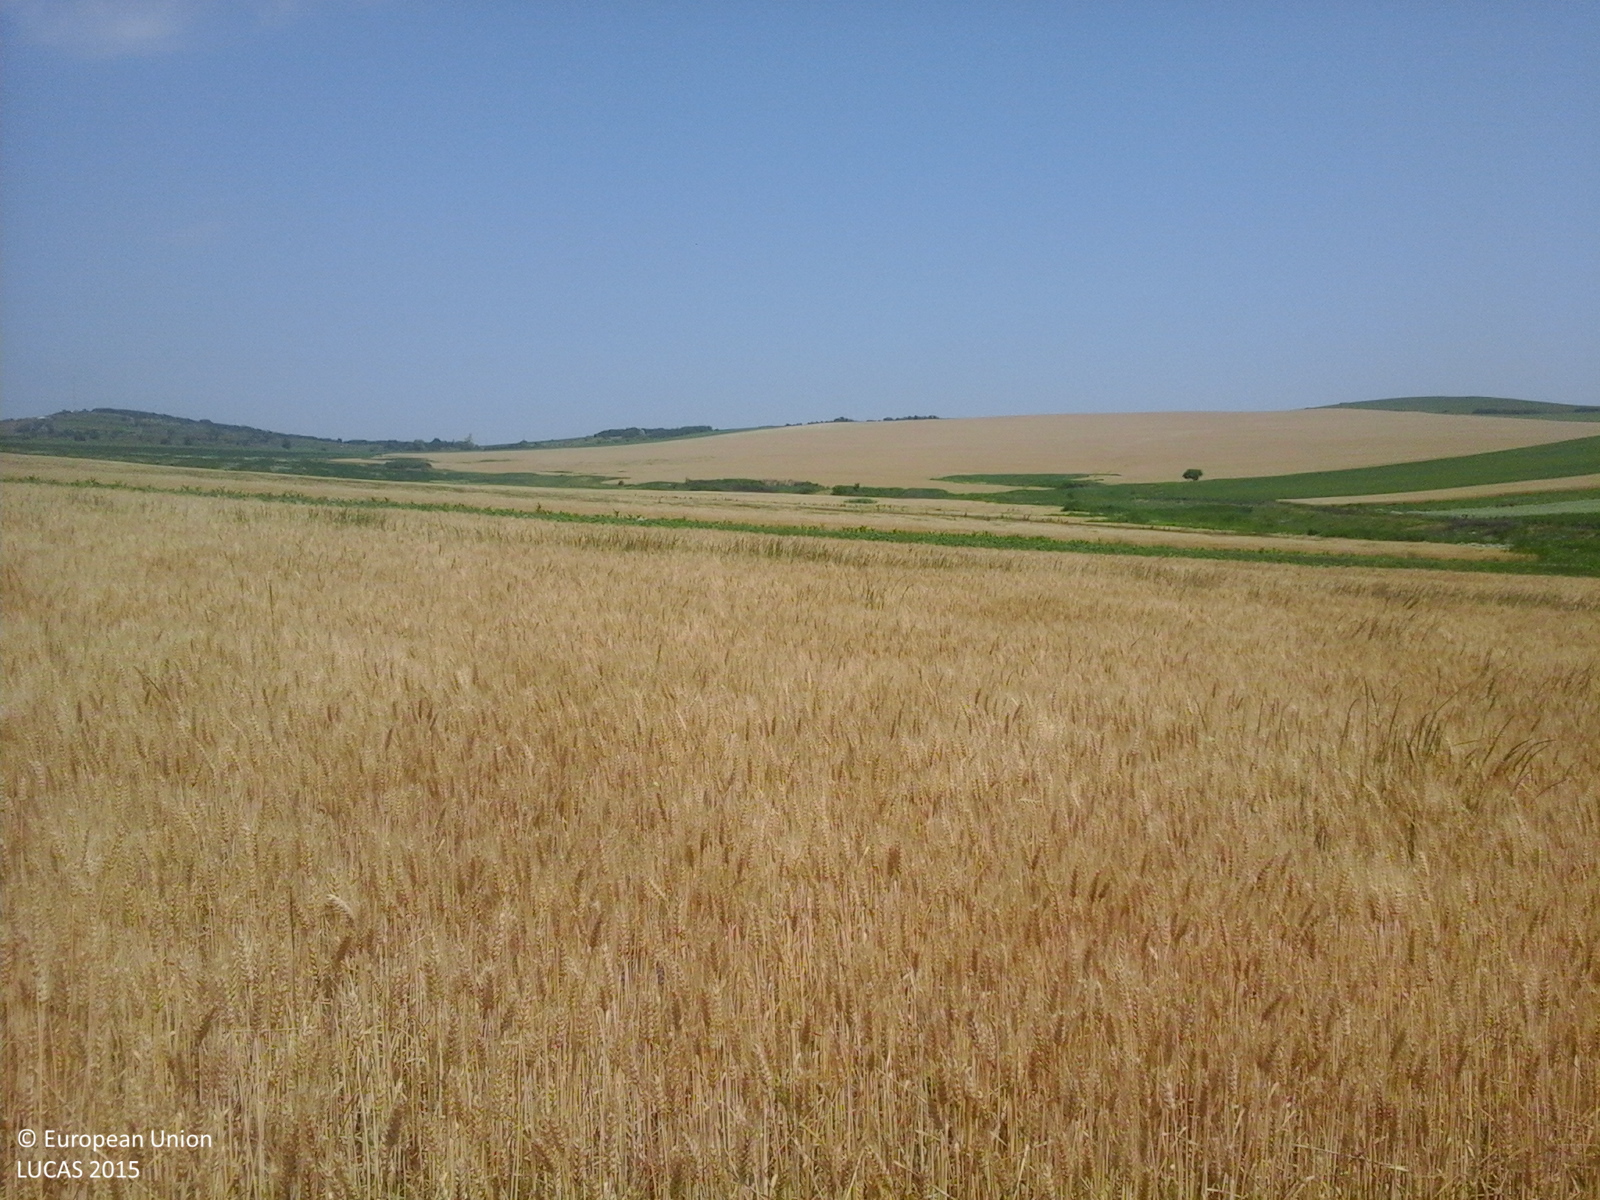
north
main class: Cropland
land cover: Common wheat
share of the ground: > 75 %
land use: Agriculture (excluding fallow land and kitchen gardens)
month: June
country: RO
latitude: 46.8769
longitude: 27.3096
